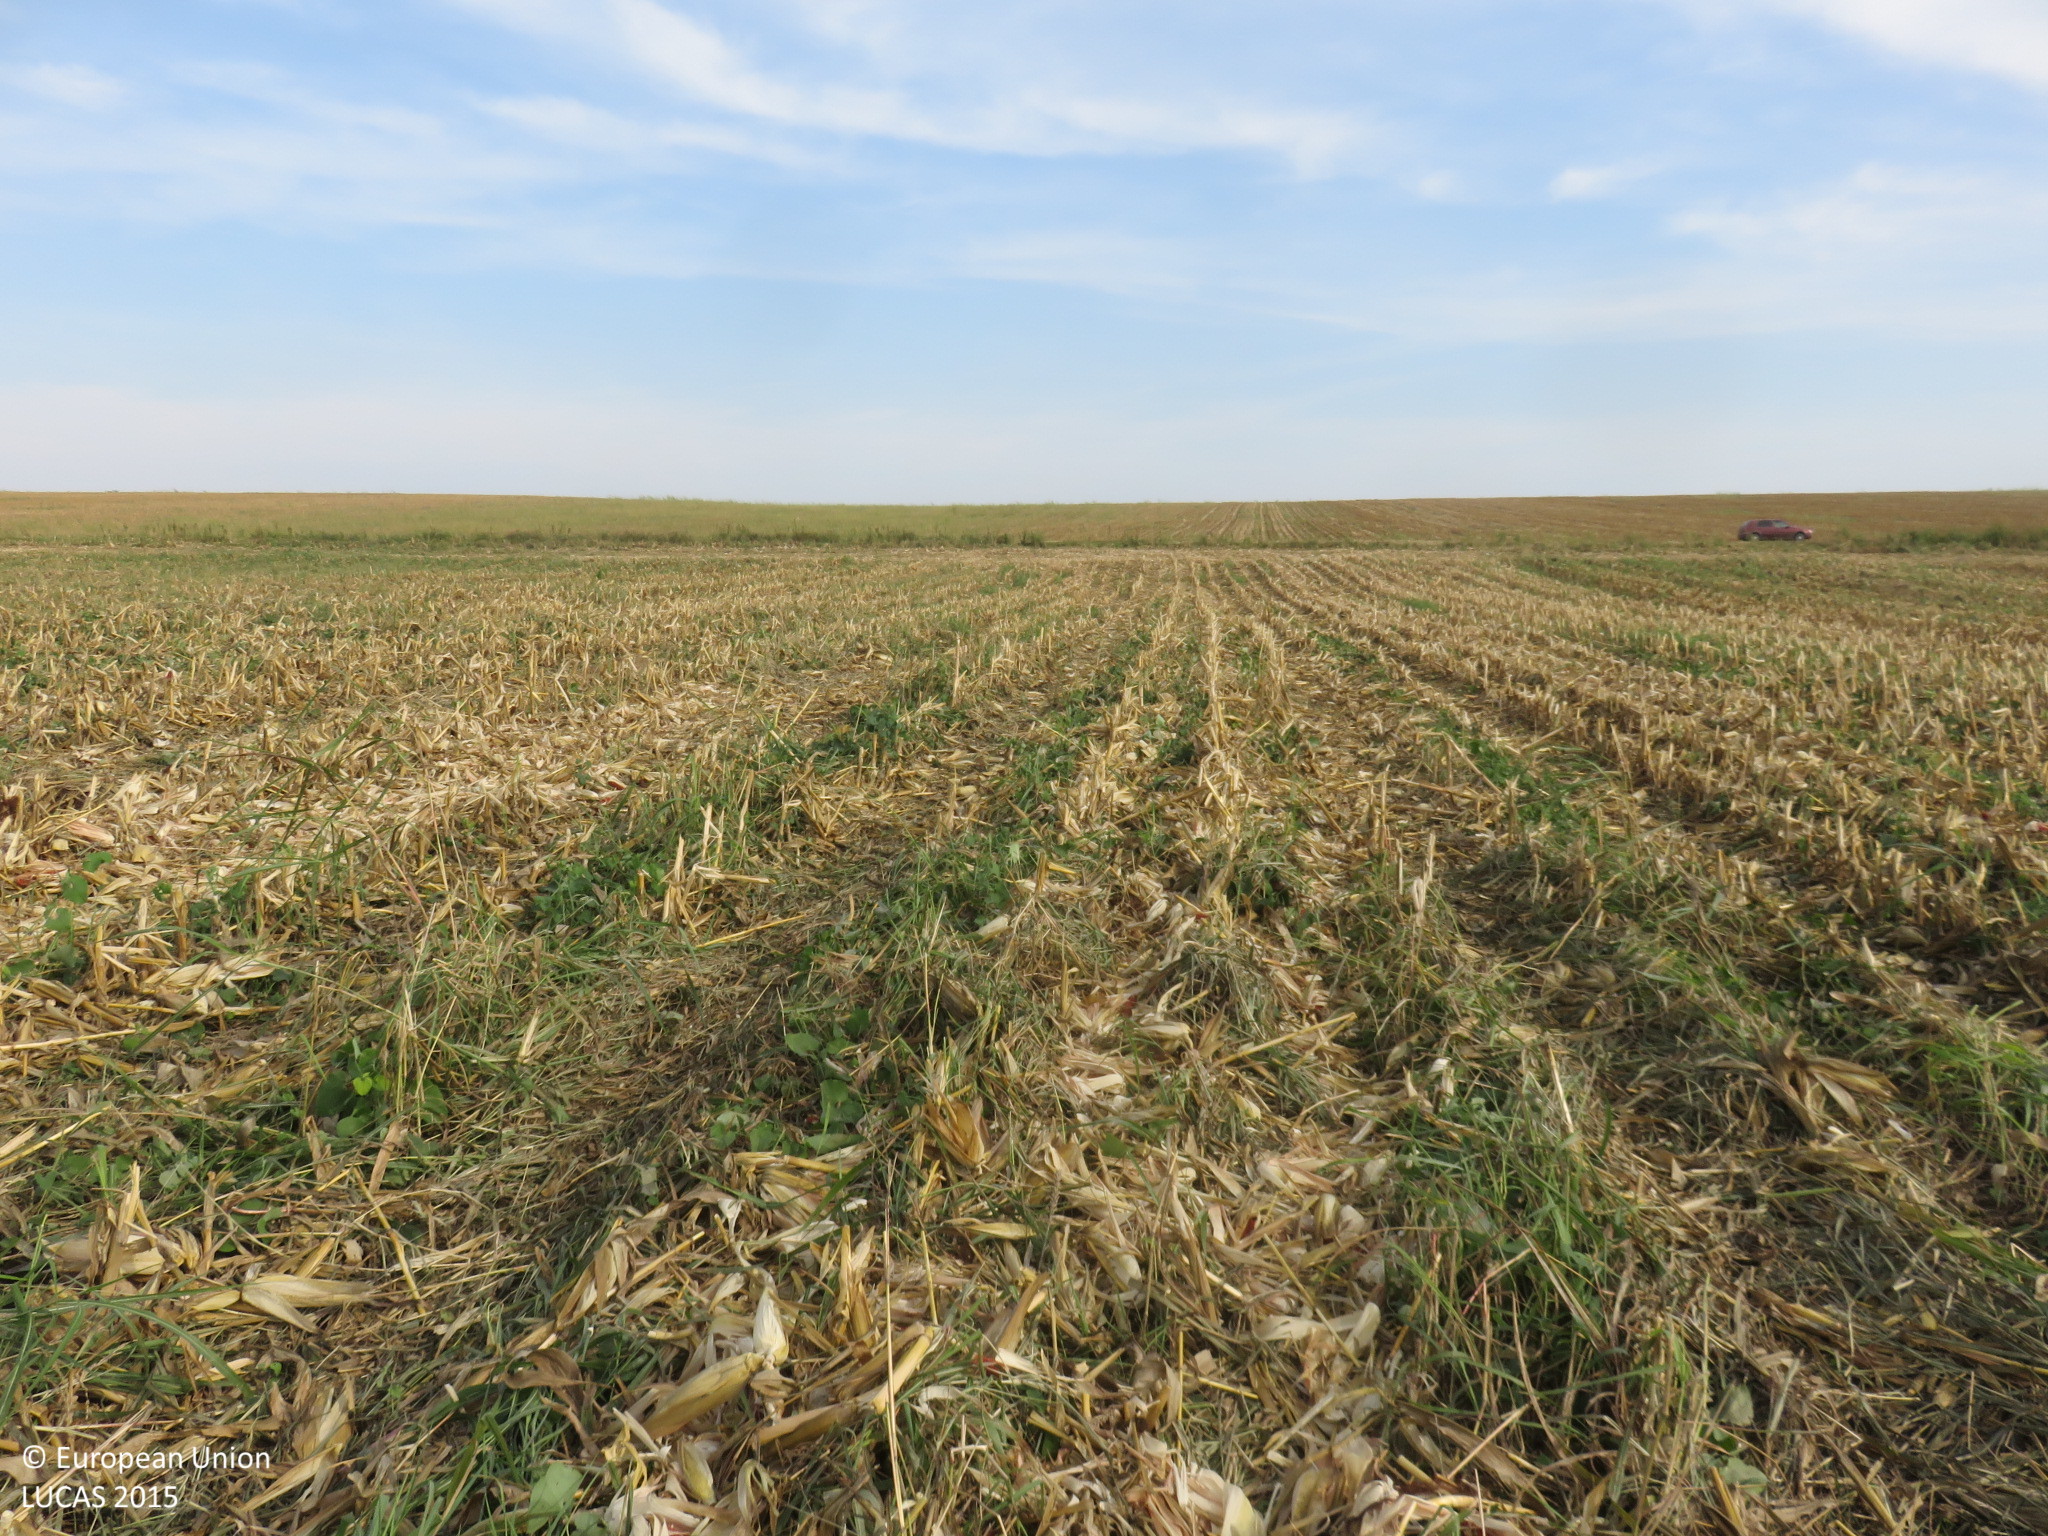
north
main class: Cropland
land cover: Maize
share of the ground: 25 - 50 %
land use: Agriculture (excluding fallow land and kitchen gardens)
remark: Harvested field
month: September
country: BG
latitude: 43.5164
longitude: 24.9525
